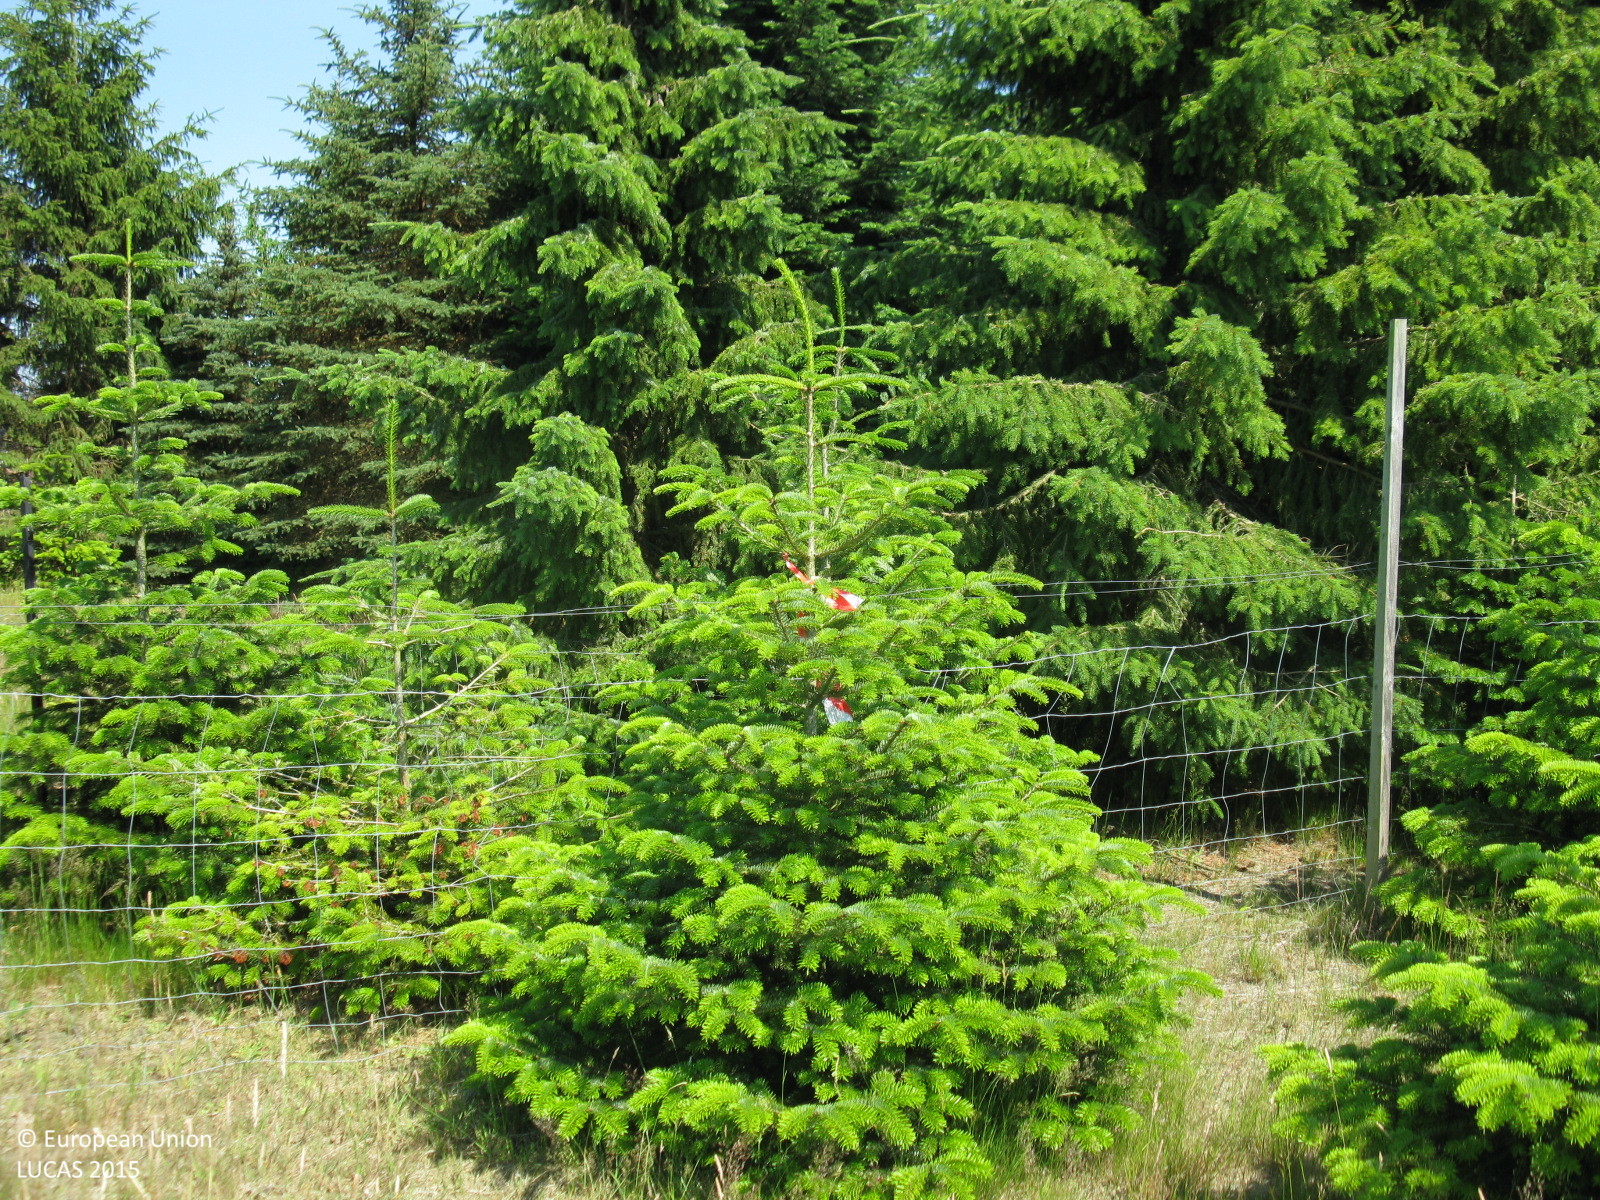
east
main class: Grassland
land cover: Spontaneously vegetated surfaces
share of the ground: > 75 %
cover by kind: herbaceous plants 100 %
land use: Agriculture (excluding fallow land and kitchen gardens)
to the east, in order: Spontaneously vegetated surfaces; Nurseries; Triticale; Fences; Grassland without tree/shrub cover; Lines of trees; Paved roads, cycling and walking lanes; Grassland without tree/shrub cover; Fences; Lines of trees; Grassland without tree/shrub cover; Apple fruit; Other mixed woodland
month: July
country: DE
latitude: 52.9132
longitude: 9.0932
